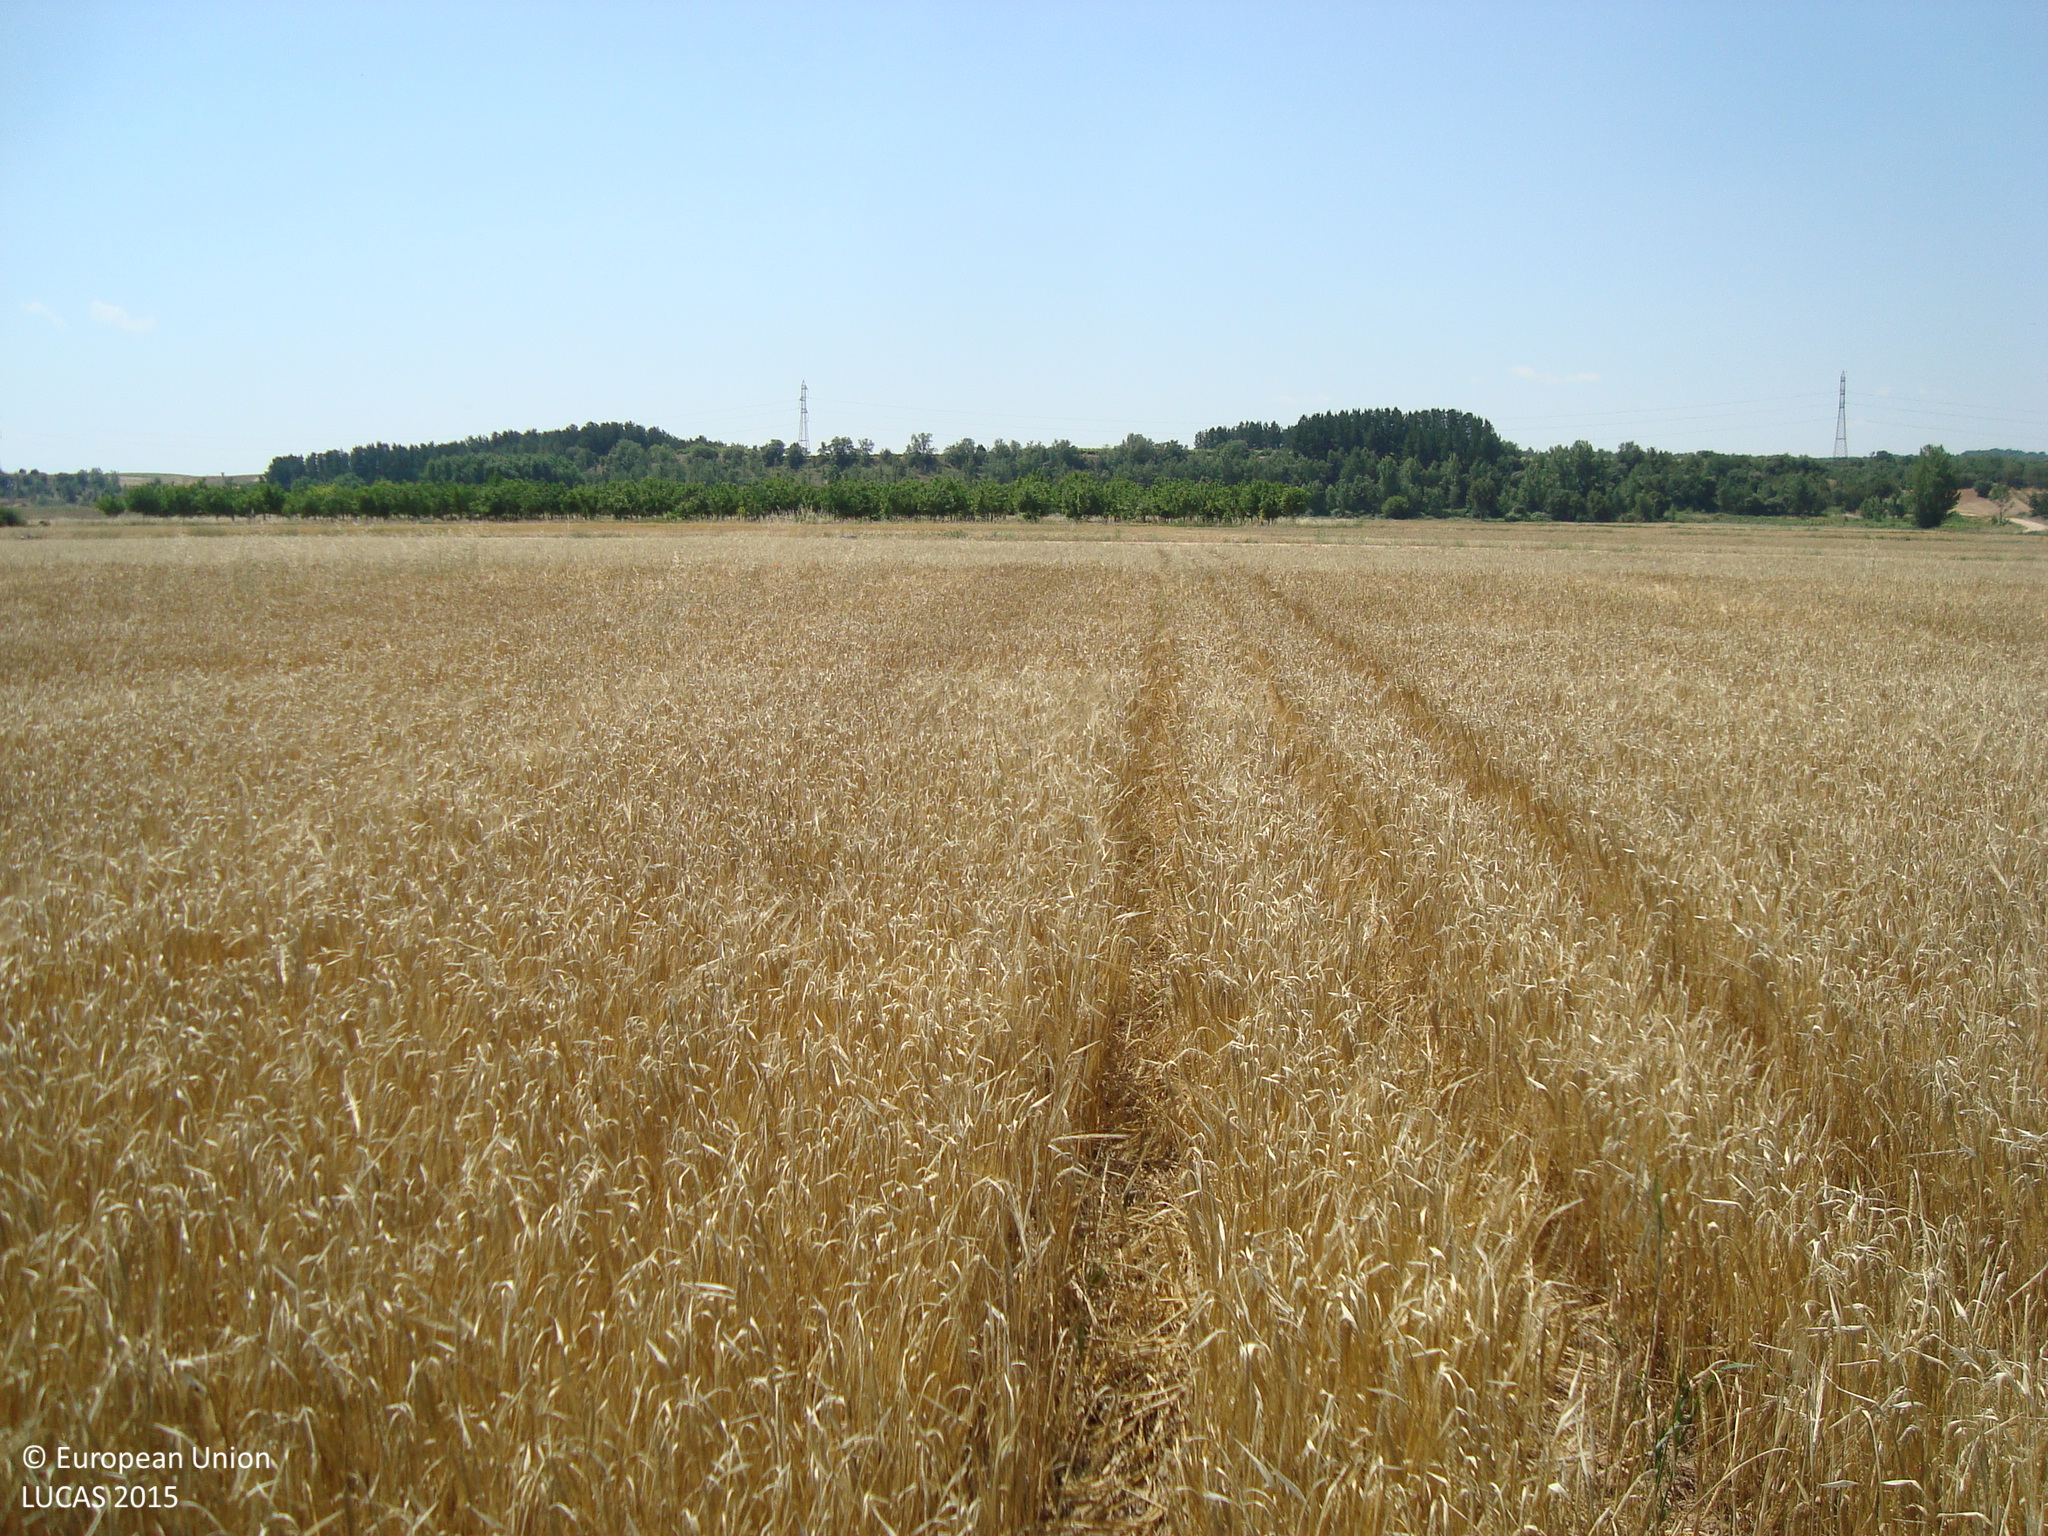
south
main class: Cropland
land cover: Barley
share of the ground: > 75 %
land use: Agriculture (excluding fallow land and kitchen gardens)
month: June
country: ES
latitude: 41.6668
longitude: -3.8063
